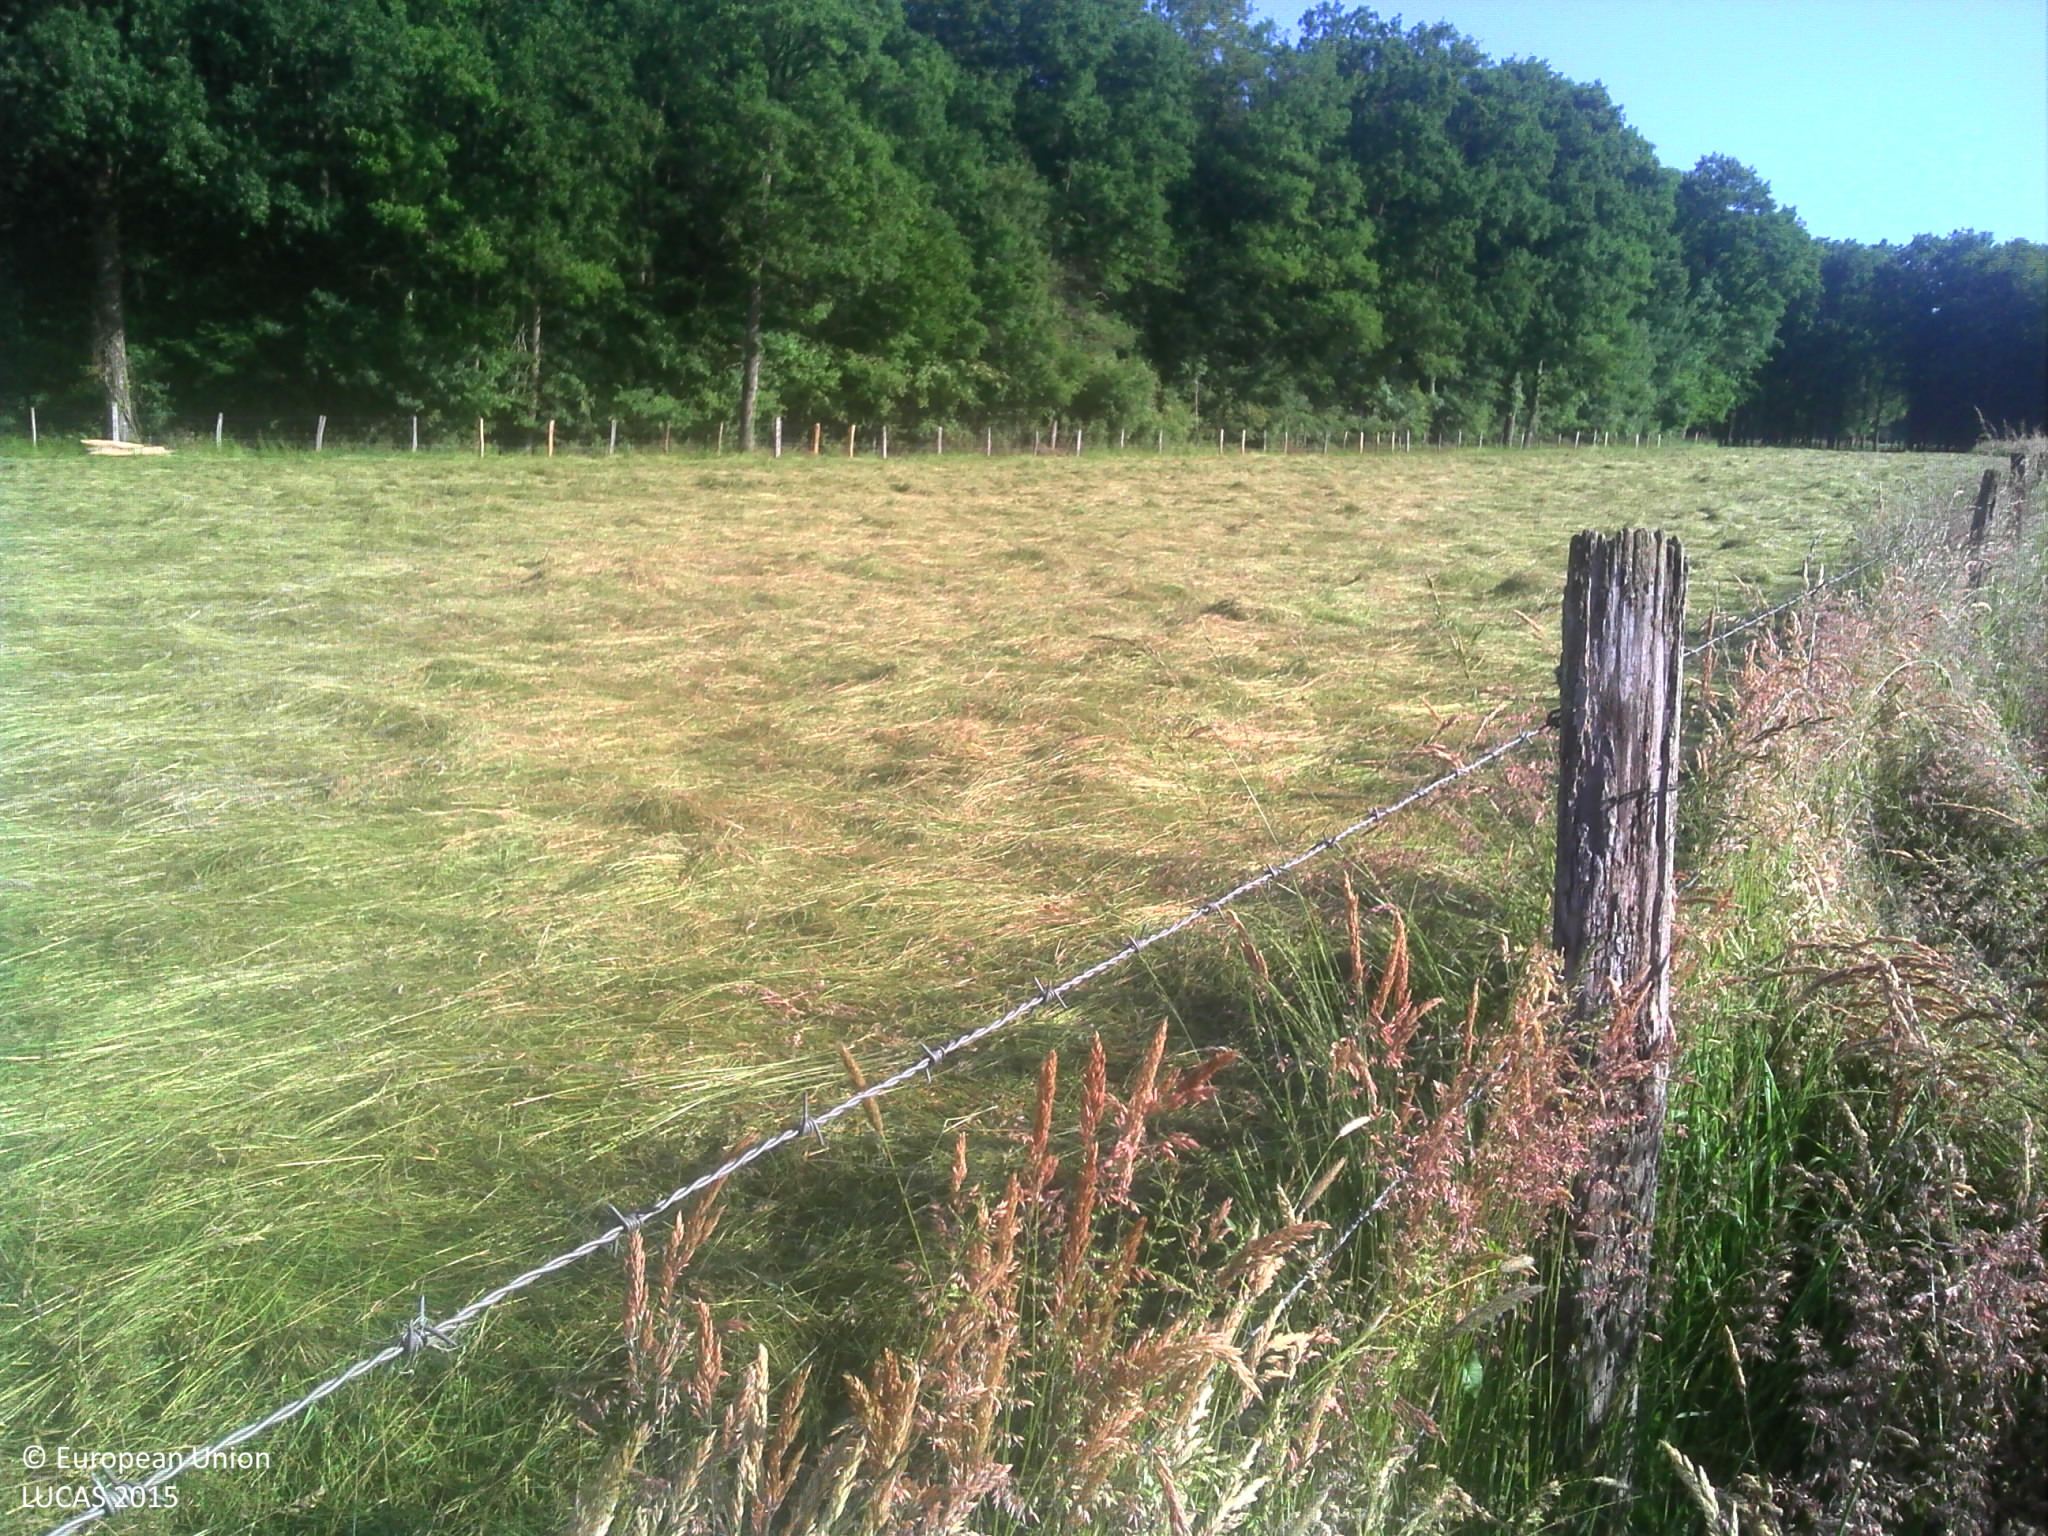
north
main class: Cropland
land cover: Triticale
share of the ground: > 75 %
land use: Agriculture (excluding fallow land and kitchen gardens)
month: June
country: FR
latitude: 48.5098
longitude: 4.6779
